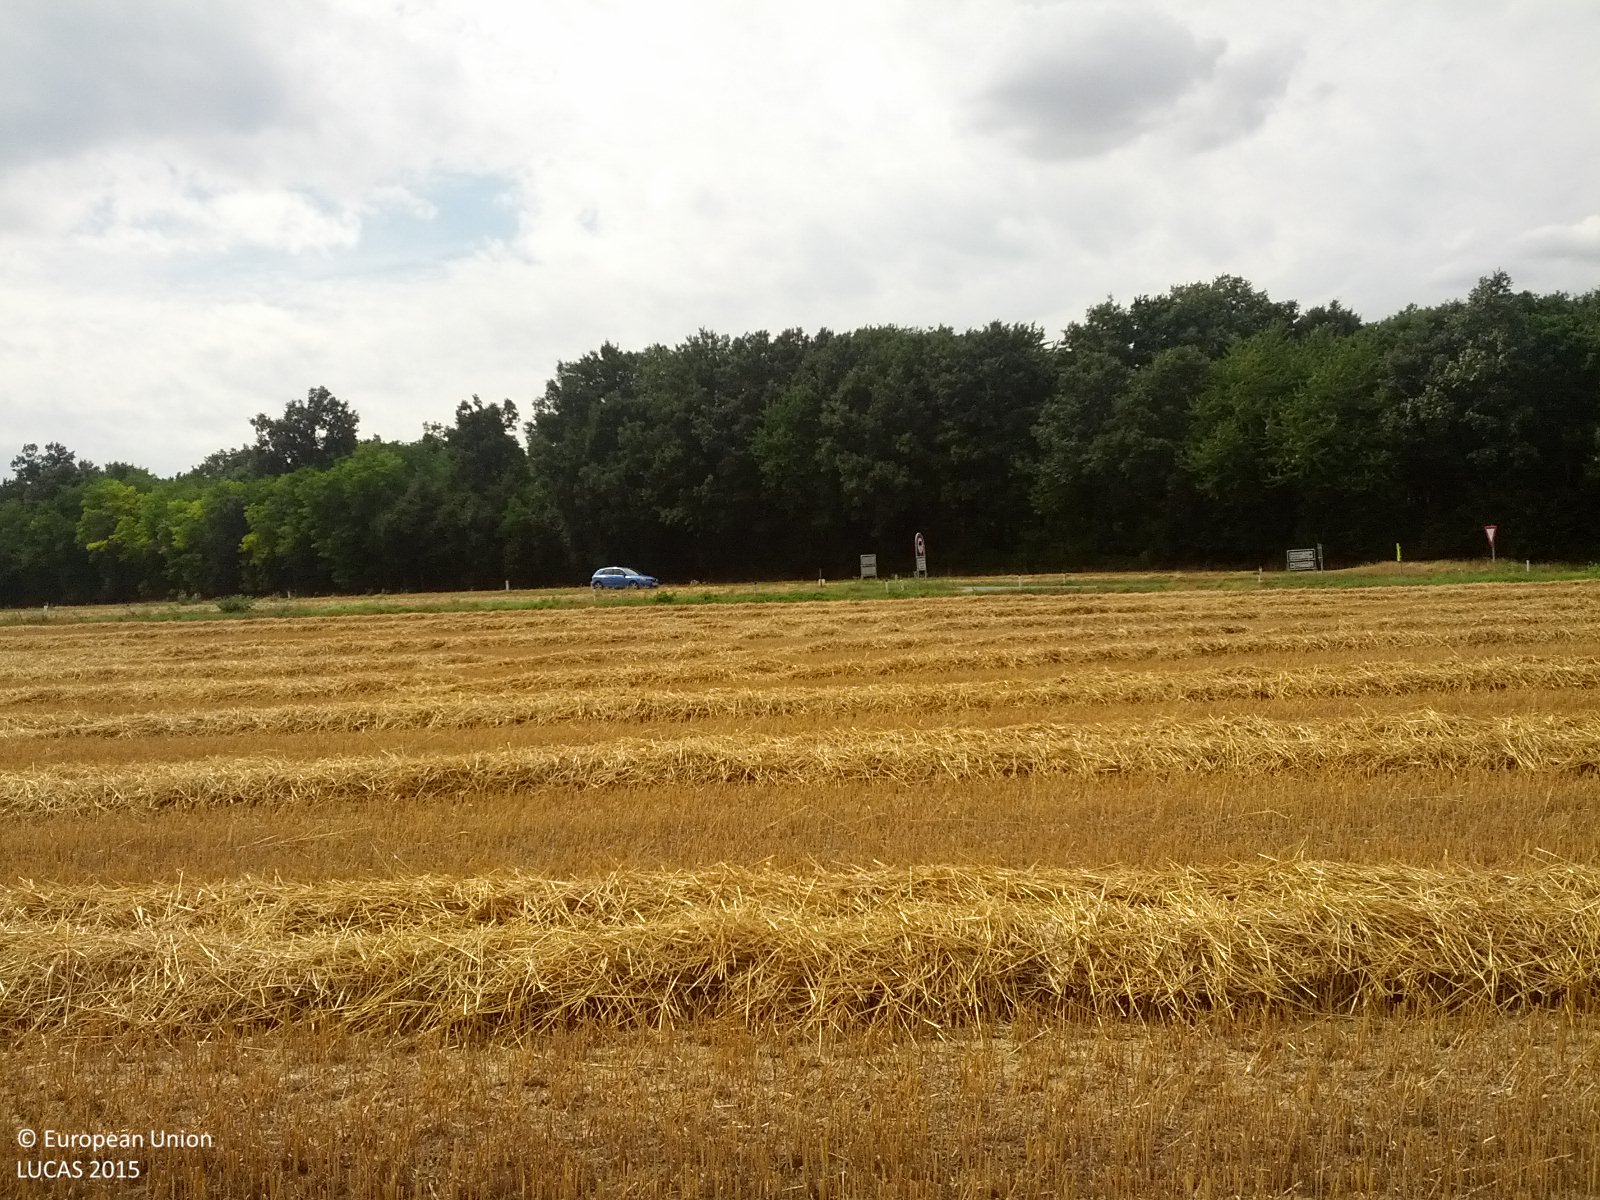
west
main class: Cropland
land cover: Common wheat
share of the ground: > 75 %
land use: Agriculture (excluding fallow land and kitchen gardens)
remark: Harvested field
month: July
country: AT
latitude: 48.5164
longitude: 16.5451
